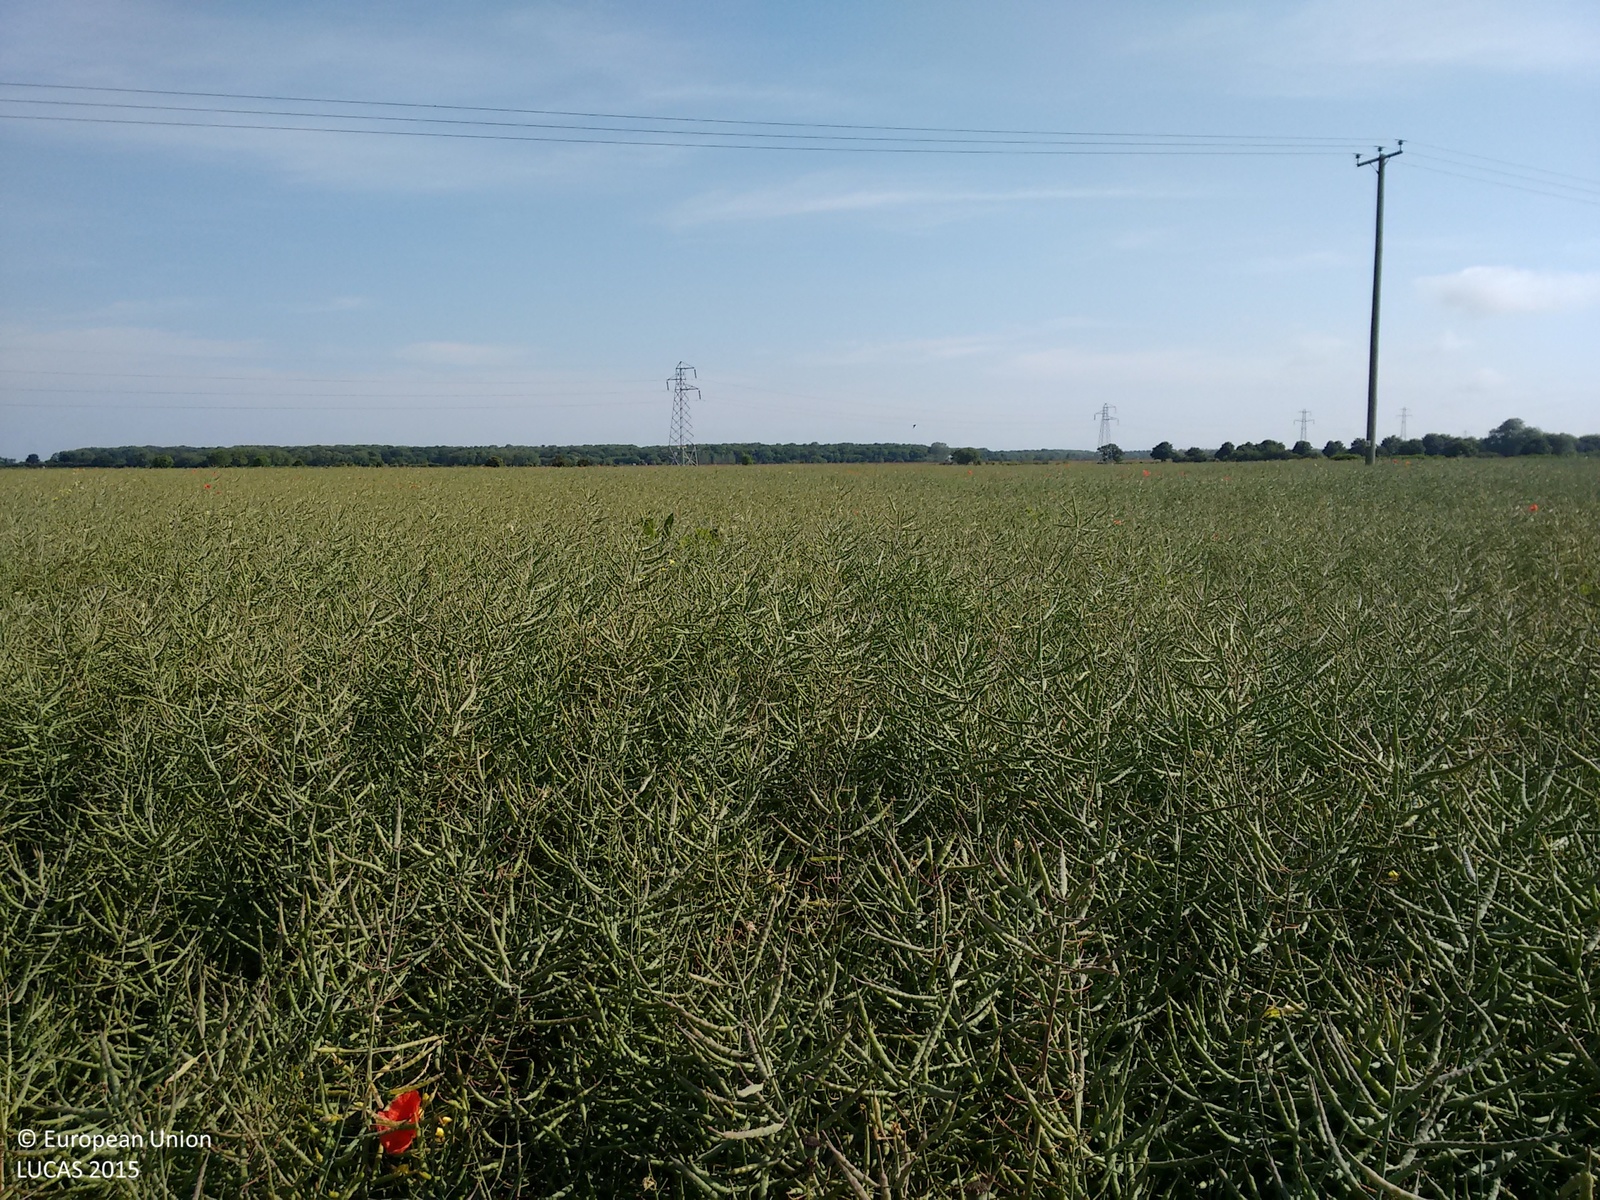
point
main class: Cropland
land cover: Rape and turnip rape
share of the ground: > 75 %
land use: Agriculture (excluding fallow land and kitchen gardens)
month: June
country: GB
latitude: 53.7733
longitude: -1.1672
